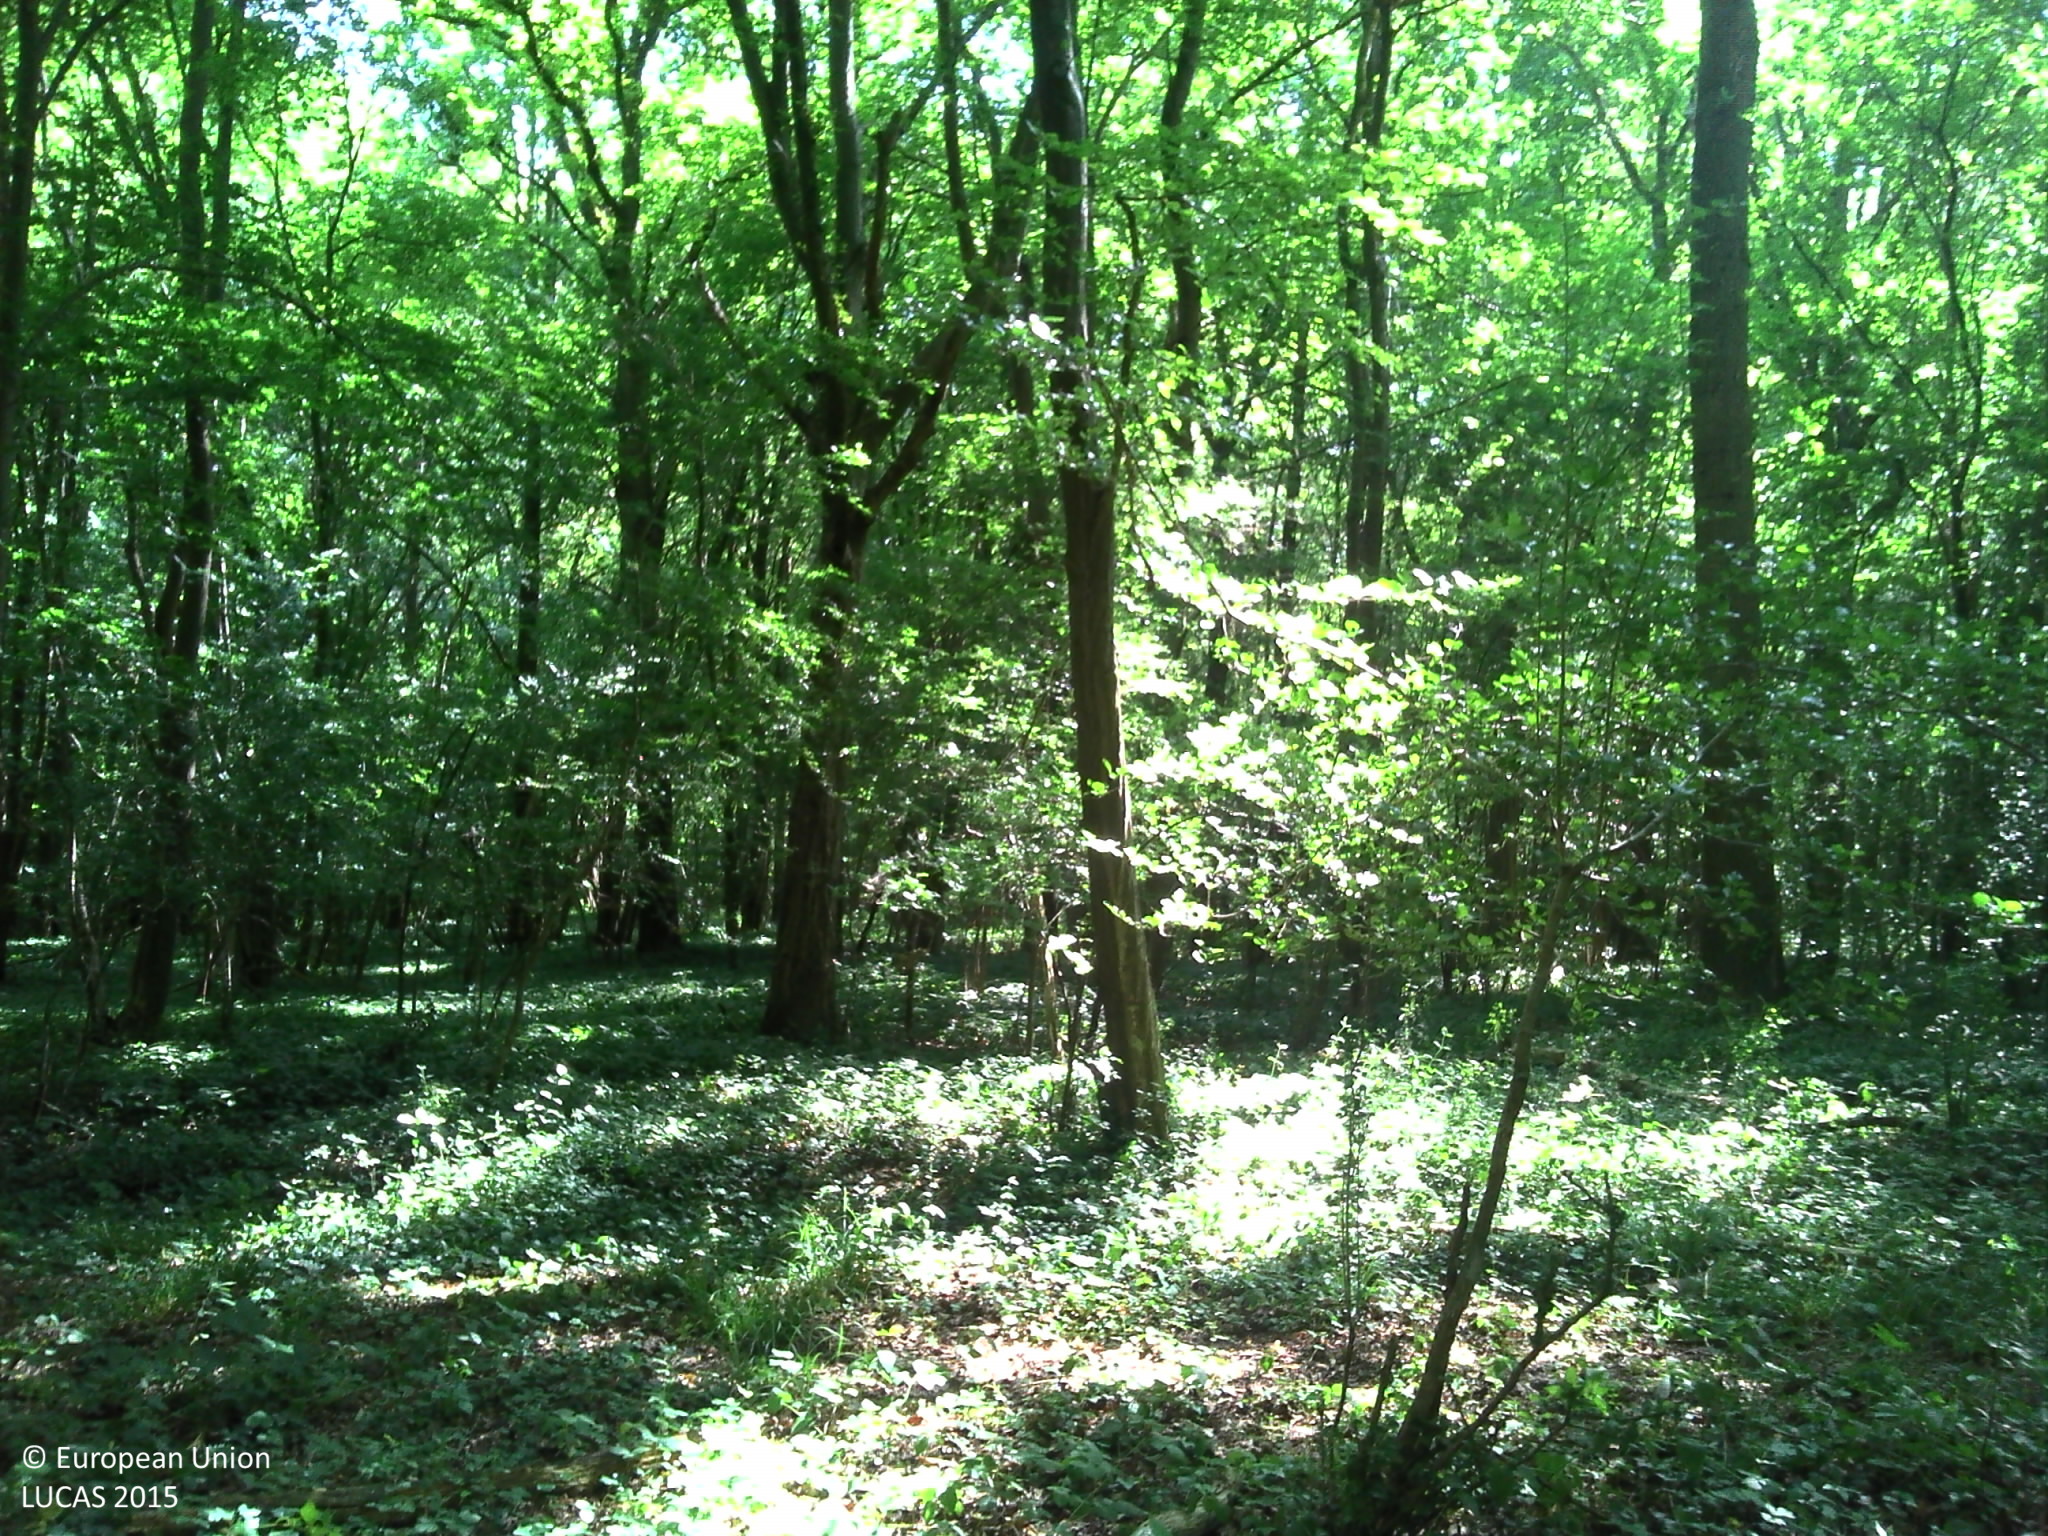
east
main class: Woodland
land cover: Broadleaved woodland
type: mesophytic deciduous forest
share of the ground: > 75 %
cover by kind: broadleaved forest trees 55 %, herbaceous plants 40 %, shrubs 5 %
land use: Forestry
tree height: > 5 m
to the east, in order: Broadleaved woodland; Groves; Grassland without tree/shrub cover; Groves; Broadleaved woodland
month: June
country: FR
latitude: 49.5423
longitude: 2.5392
